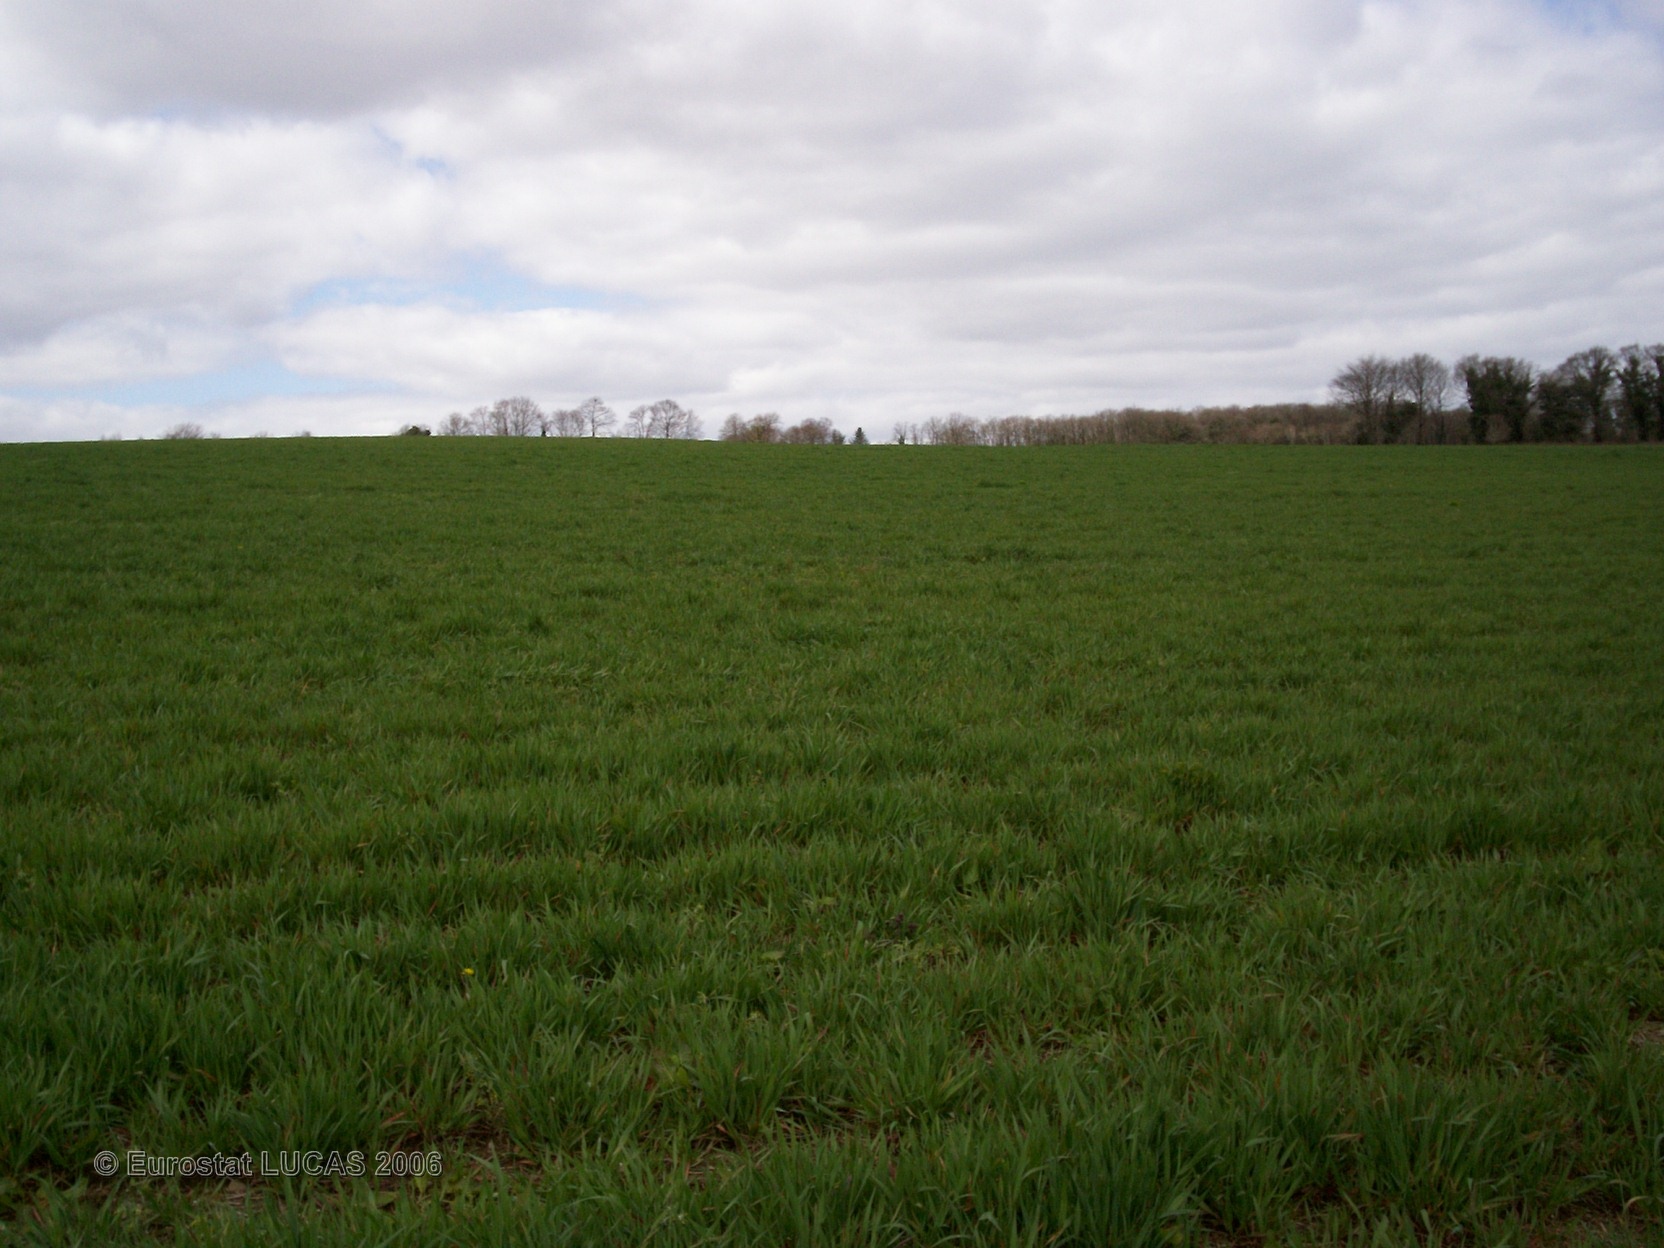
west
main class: Cropland
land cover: Oats
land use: Agriculture (excluding fallow land and kitchen gardens)
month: April
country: FR
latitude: 48.2321
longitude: -3.6101
